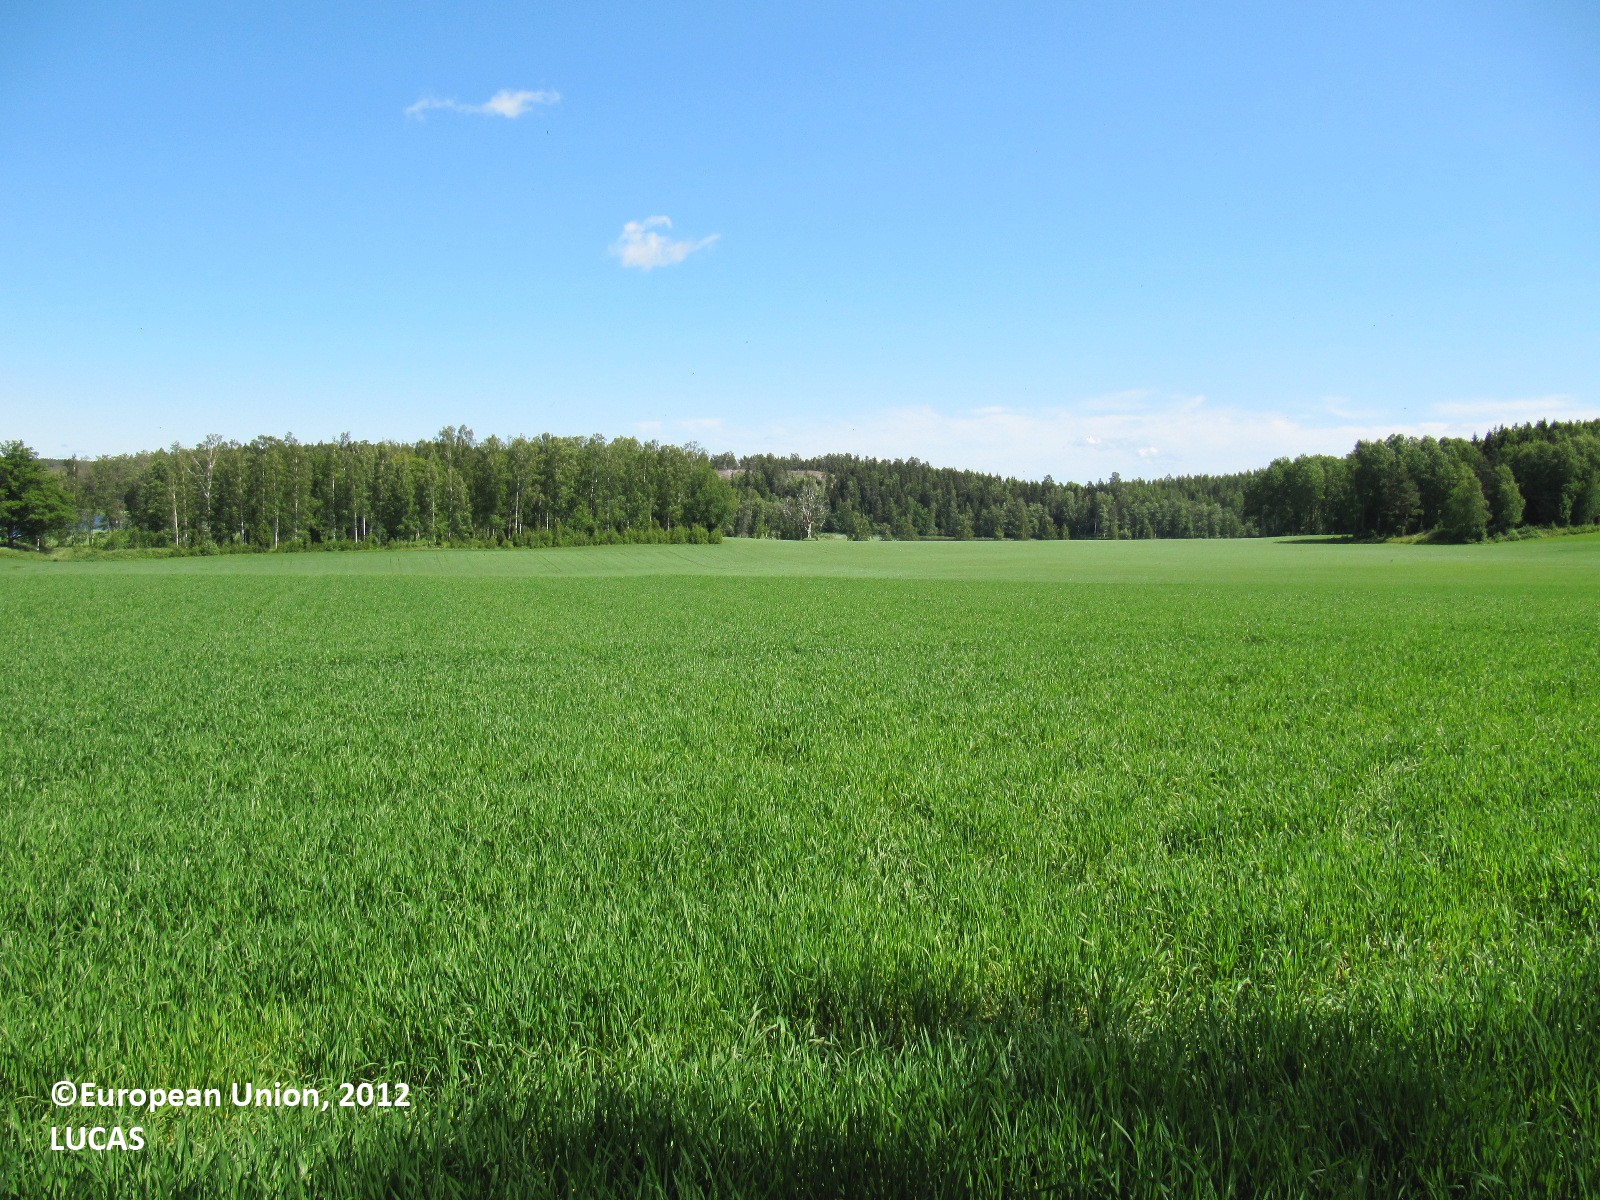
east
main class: Cropland
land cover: Barley
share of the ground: > 75 %
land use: Agriculture (excluding fallow land and kitchen gardens)
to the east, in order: Barley; Broadleaved woodland
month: June
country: FI
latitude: 60.0065
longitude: 23.0846
